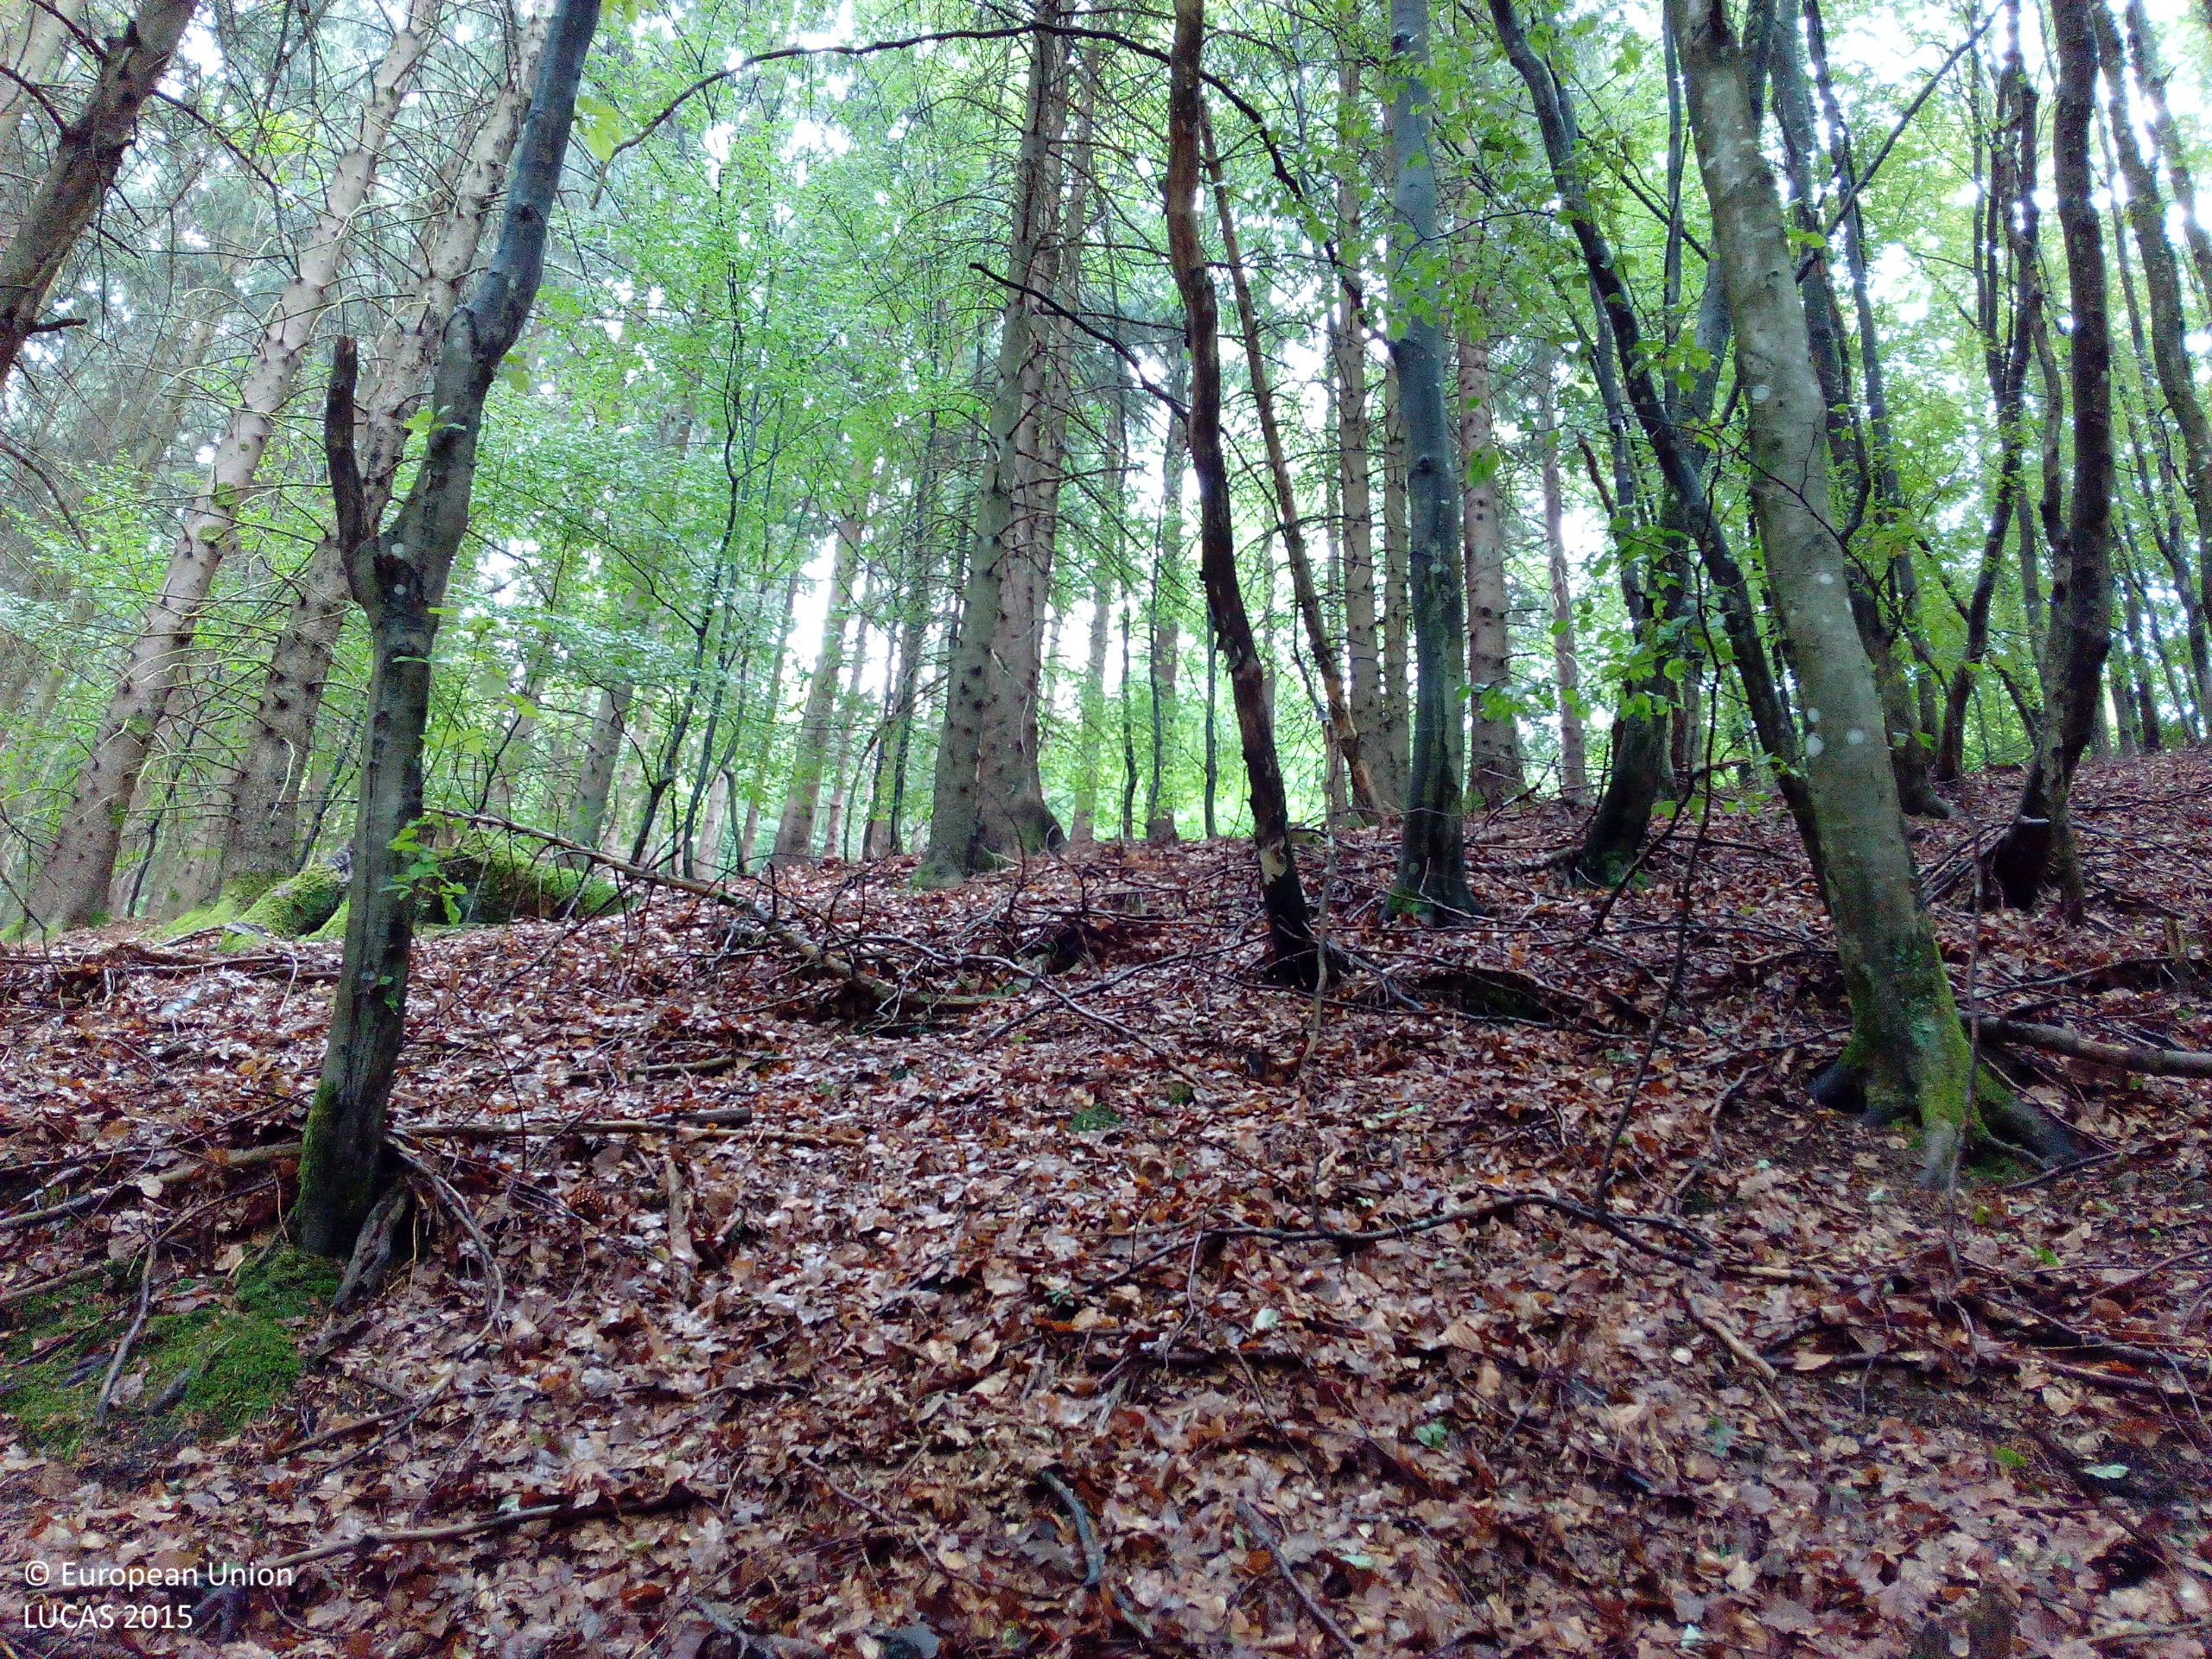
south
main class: Woodland
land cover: Broadleaved woodland
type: beech forest
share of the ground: > 75 %
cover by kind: broadleaved forest trees 90 %, unconsolidated bare surface 10 %
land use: Forestry
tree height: > 5 m
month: July
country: DE
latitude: 48.1713
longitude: 8.1050
